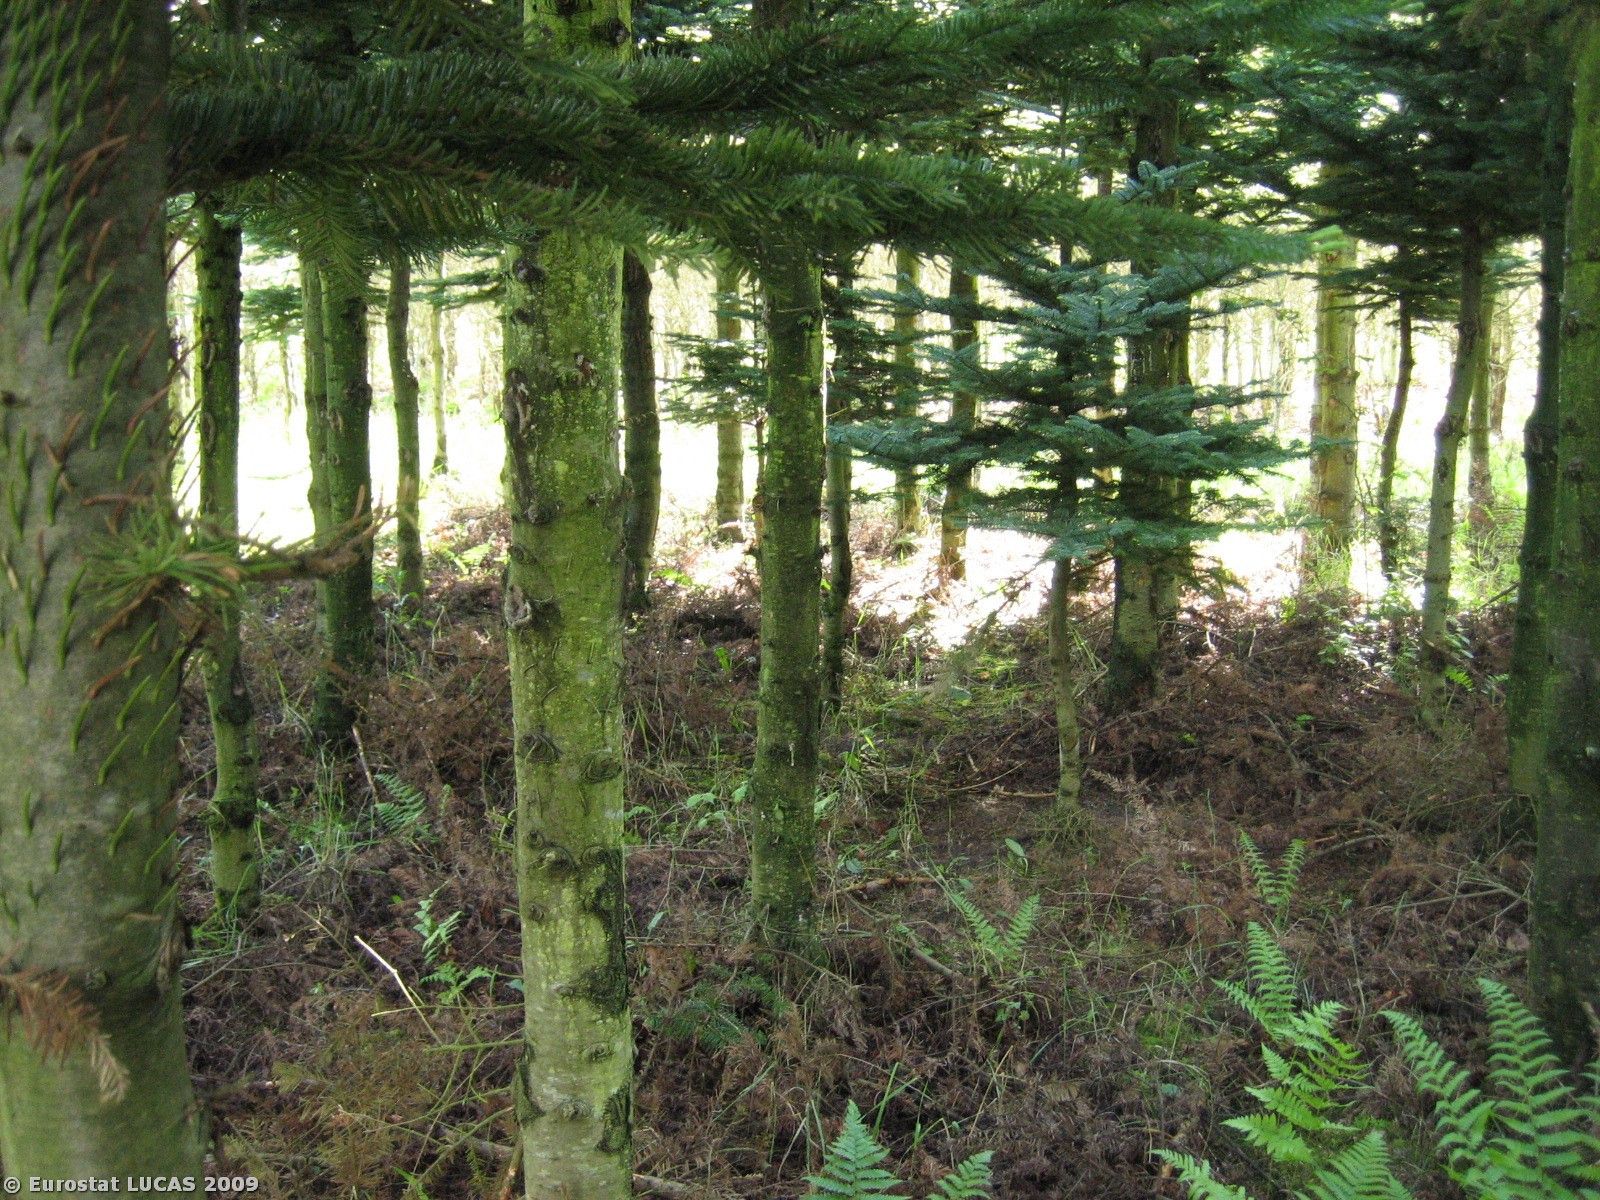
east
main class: Woodland
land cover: Coniferous woodland
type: hemiboreal forest and nemoral coniferous forest and mixed broadleaved-coniferous forest
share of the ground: > 75 %
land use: Forestry
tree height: > 5 m
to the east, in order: Coniferous woodland; Grassland without tree/shrub cover; Broadleaved woodland; Grass margins; Paved roads, cycling and walking lanes; Grass margins; Broadleaved woodland; Grass margins; Coniferous woodland; Grass margins; Coniferous woodland; Grass margins; Coniferous woodland; Grass margins; Coniferous woodland; Grass margins; Coniferous woodland; Tracks; Fences; Grassland without tree/shrub cover; Broadleaved woodland
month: May
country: DK
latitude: 55.8801
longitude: 9.2814
